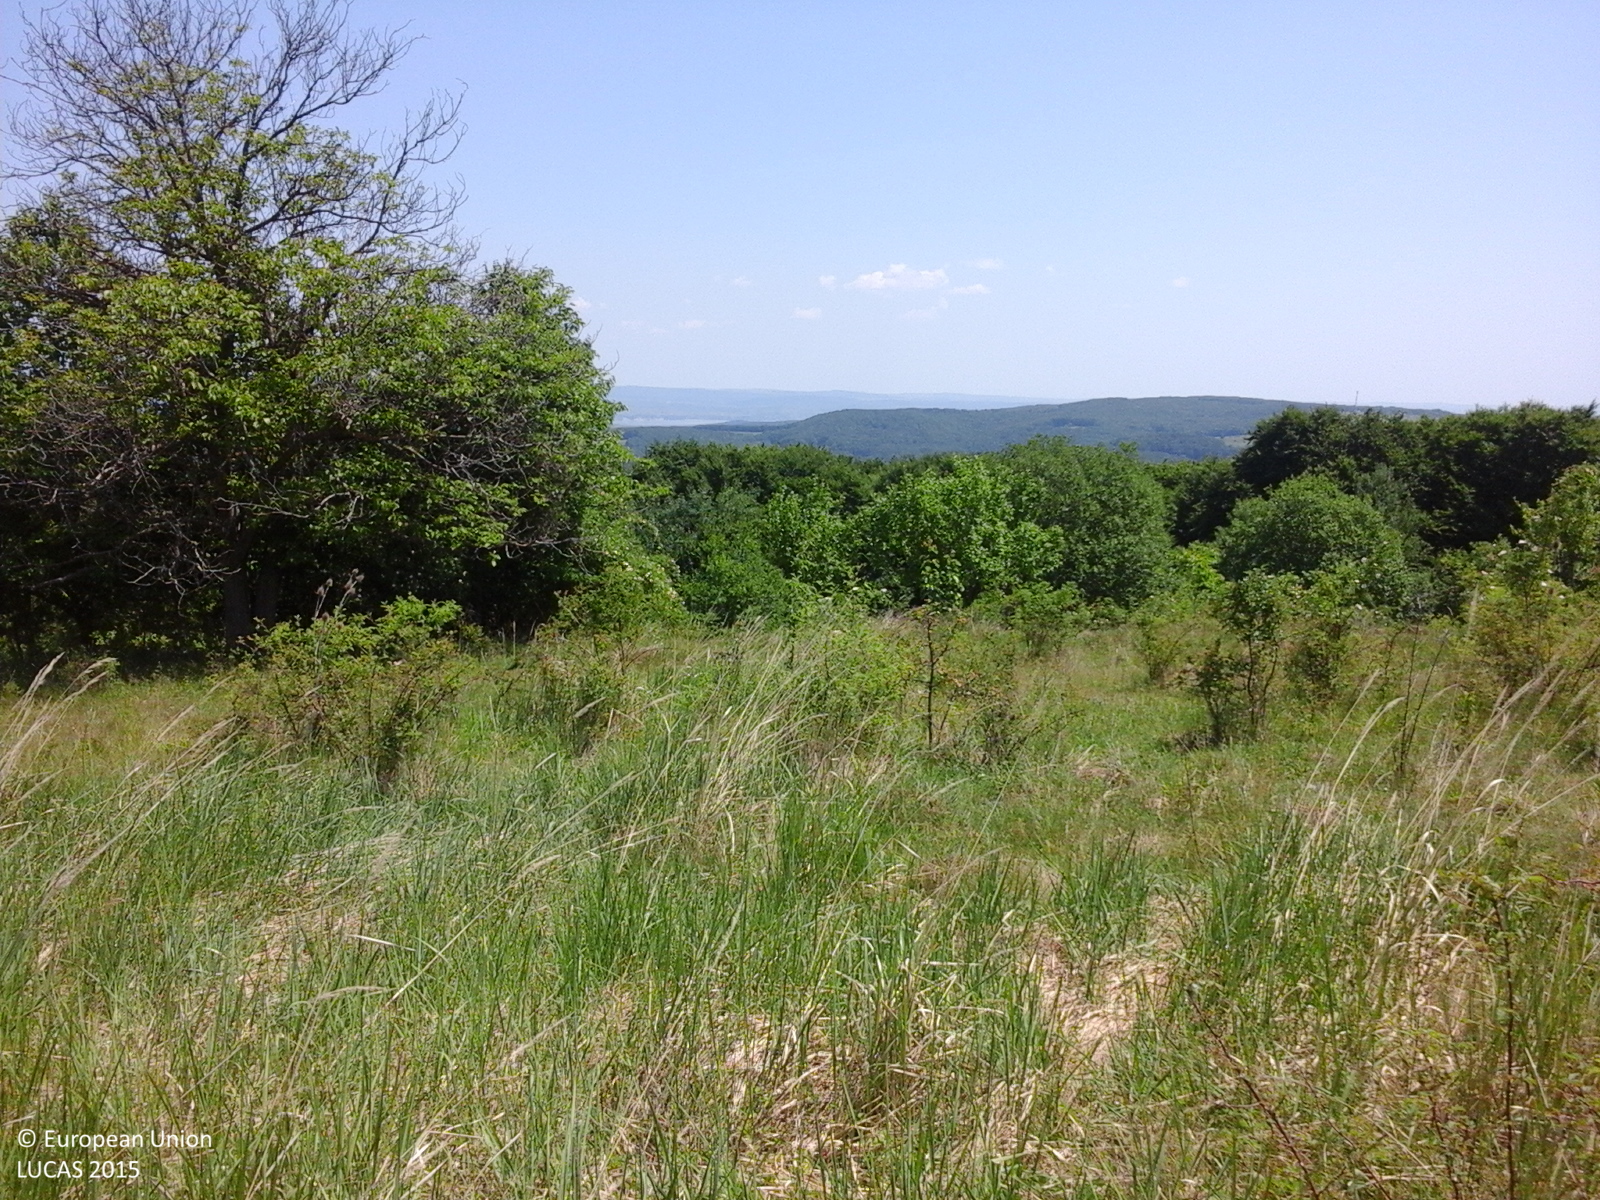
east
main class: Grassland
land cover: Grassland without tree/shrub cover
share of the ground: > 75 %
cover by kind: herbaceous plants 95 %, shrubs 5 %
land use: Agriculture (excluding fallow land and kitchen gardens)
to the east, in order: Grassland without tree/shrub cover; Shrubland with sparse tree cover; Grassland with sparse tree/shrub cover; Broadleaved woodland
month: June
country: RO
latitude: 46.3459
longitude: 26.8389
